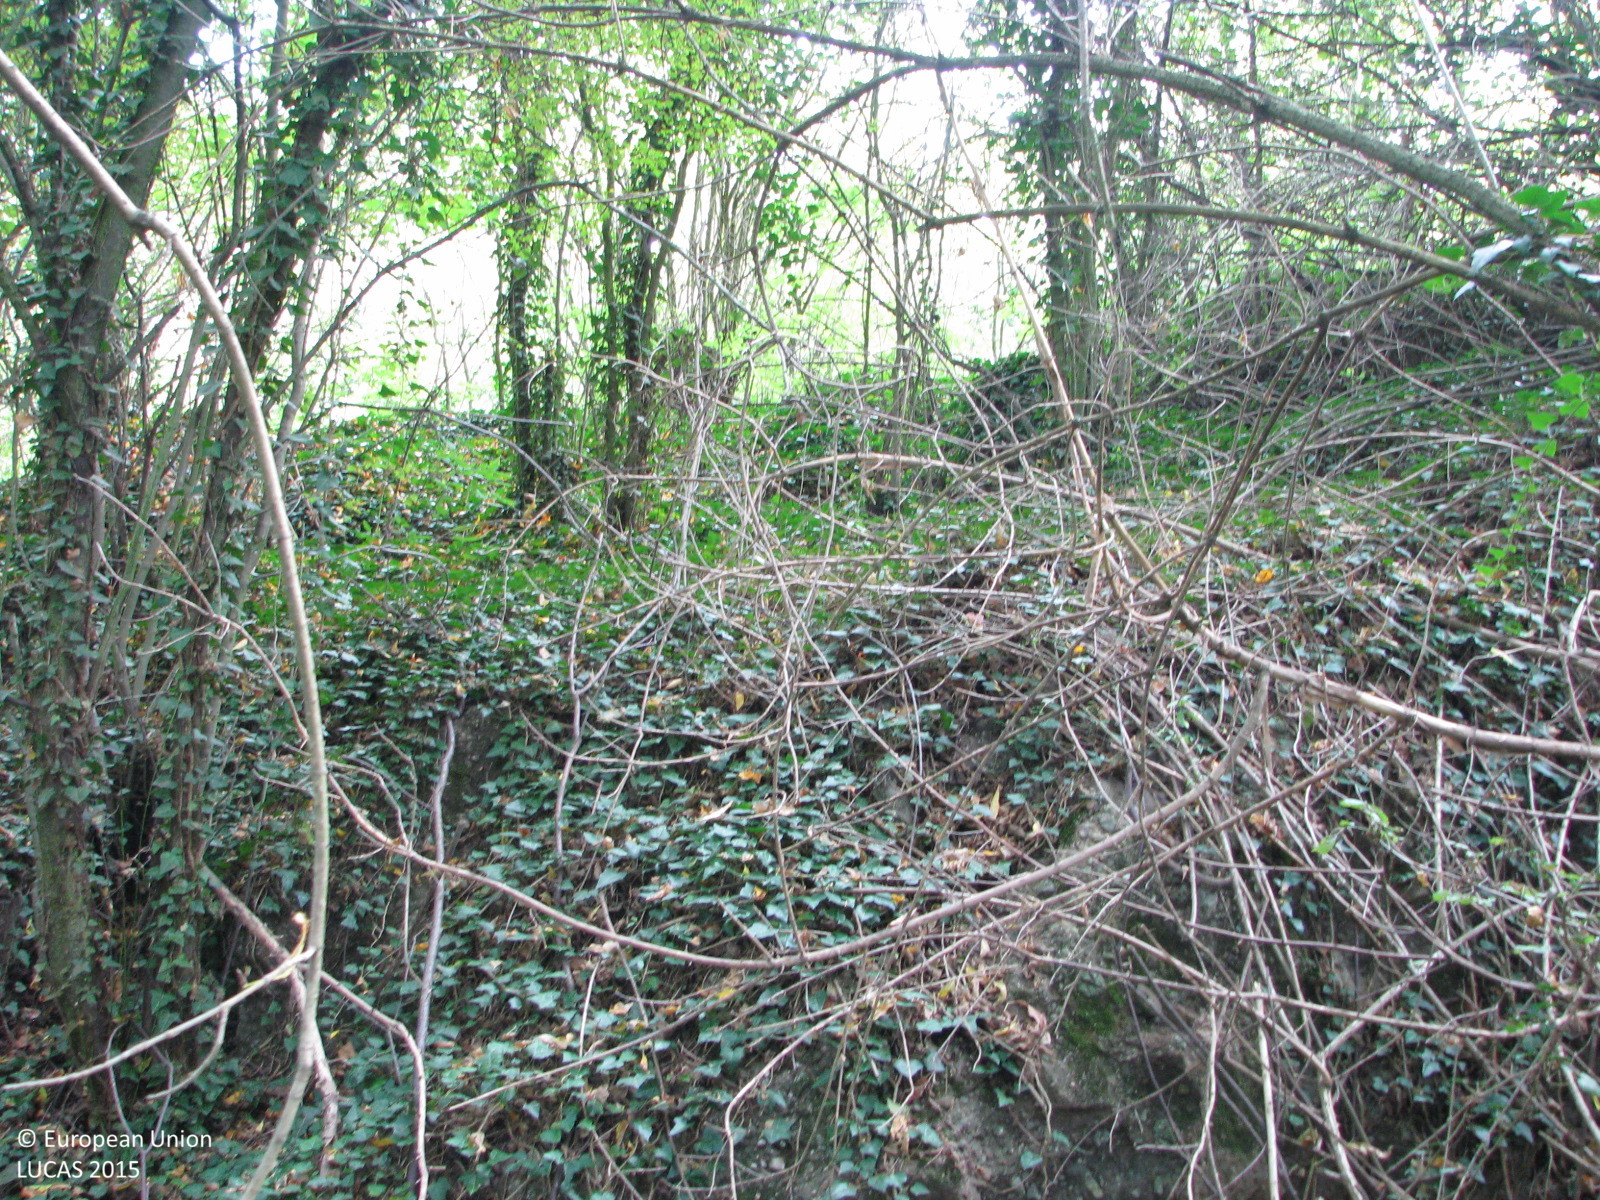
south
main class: Woodland
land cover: Broadleaved woodland
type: mesophytic deciduous forest
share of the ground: 50 - 75 %
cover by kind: broadleaved forest trees 60 %, shrubs 30 %, herbaceous plants 10 %
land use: Forestry
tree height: > 5 m
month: October
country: BG
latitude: 42.4261
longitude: 26.1885
